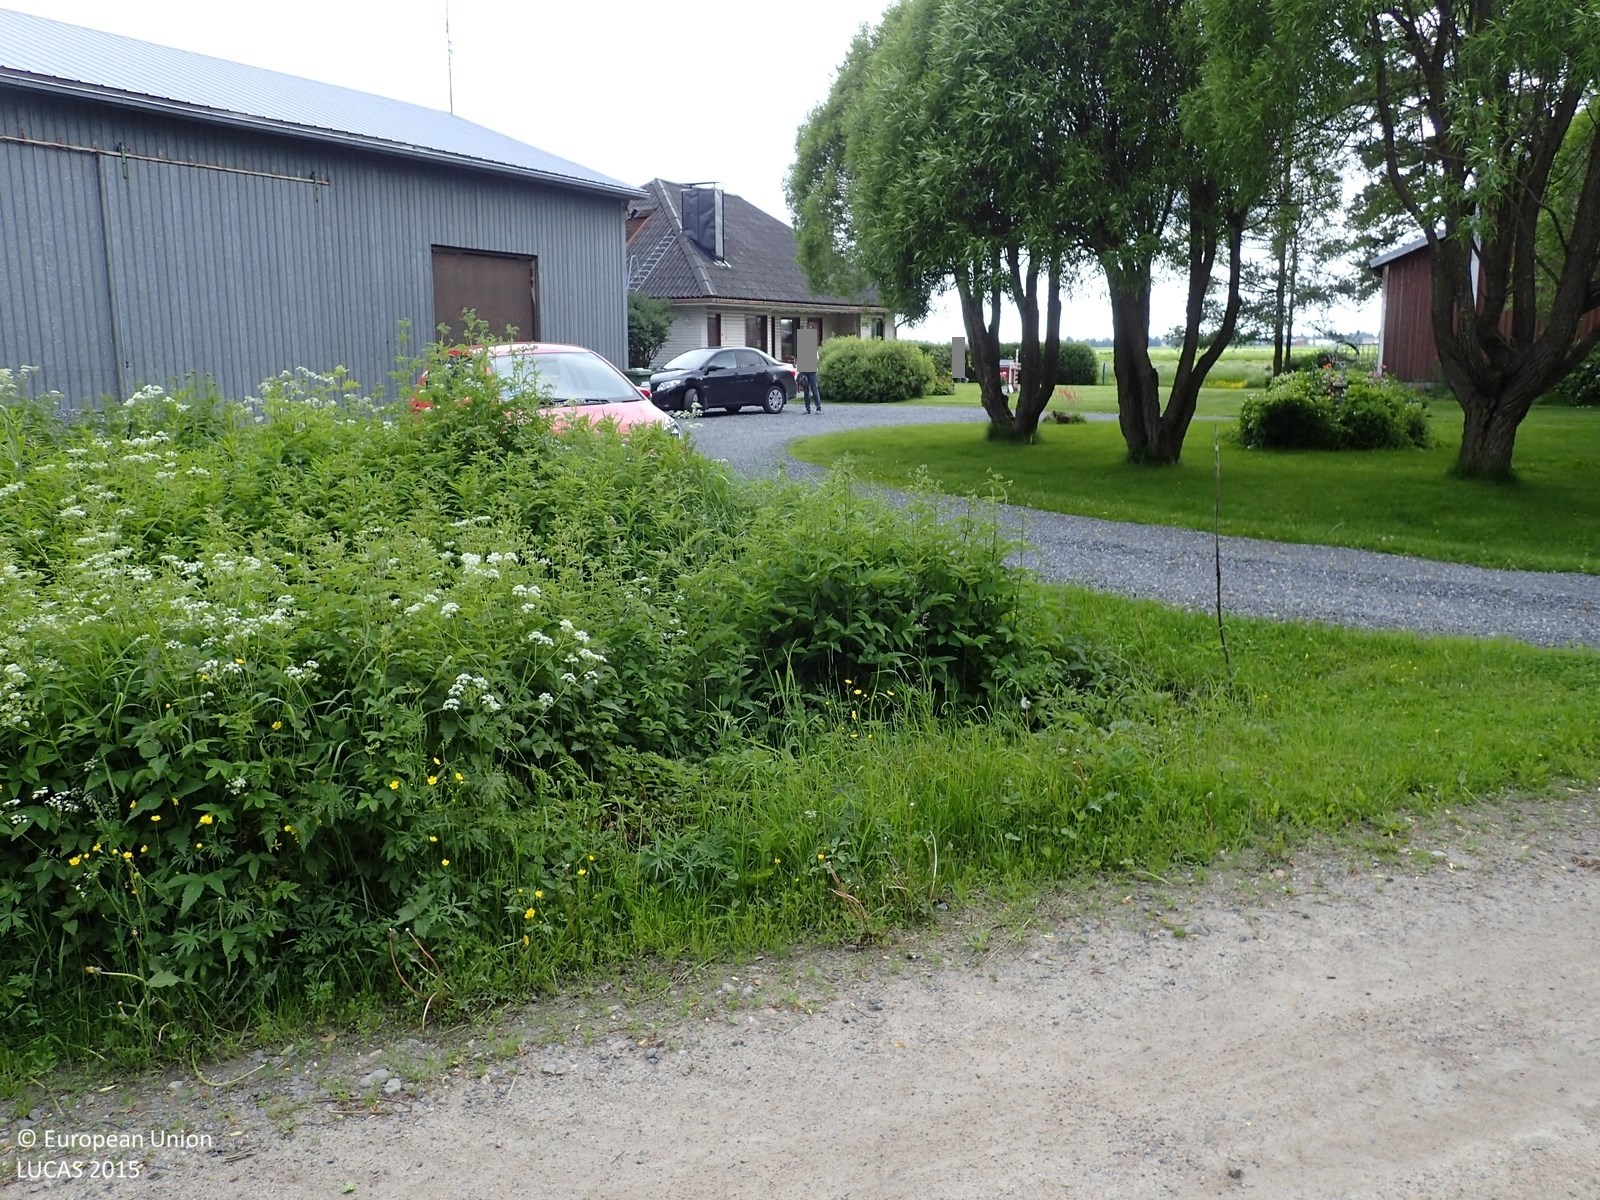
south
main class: Woodland
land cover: Broadleaved woodland
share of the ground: 50 - 75 %
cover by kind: broadleaved forest trees 55 %, herbaceous plants 45 %
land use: Semi-natural and natural areas not in use
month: June
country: FI
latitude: 62.5597
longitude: 21.4211
